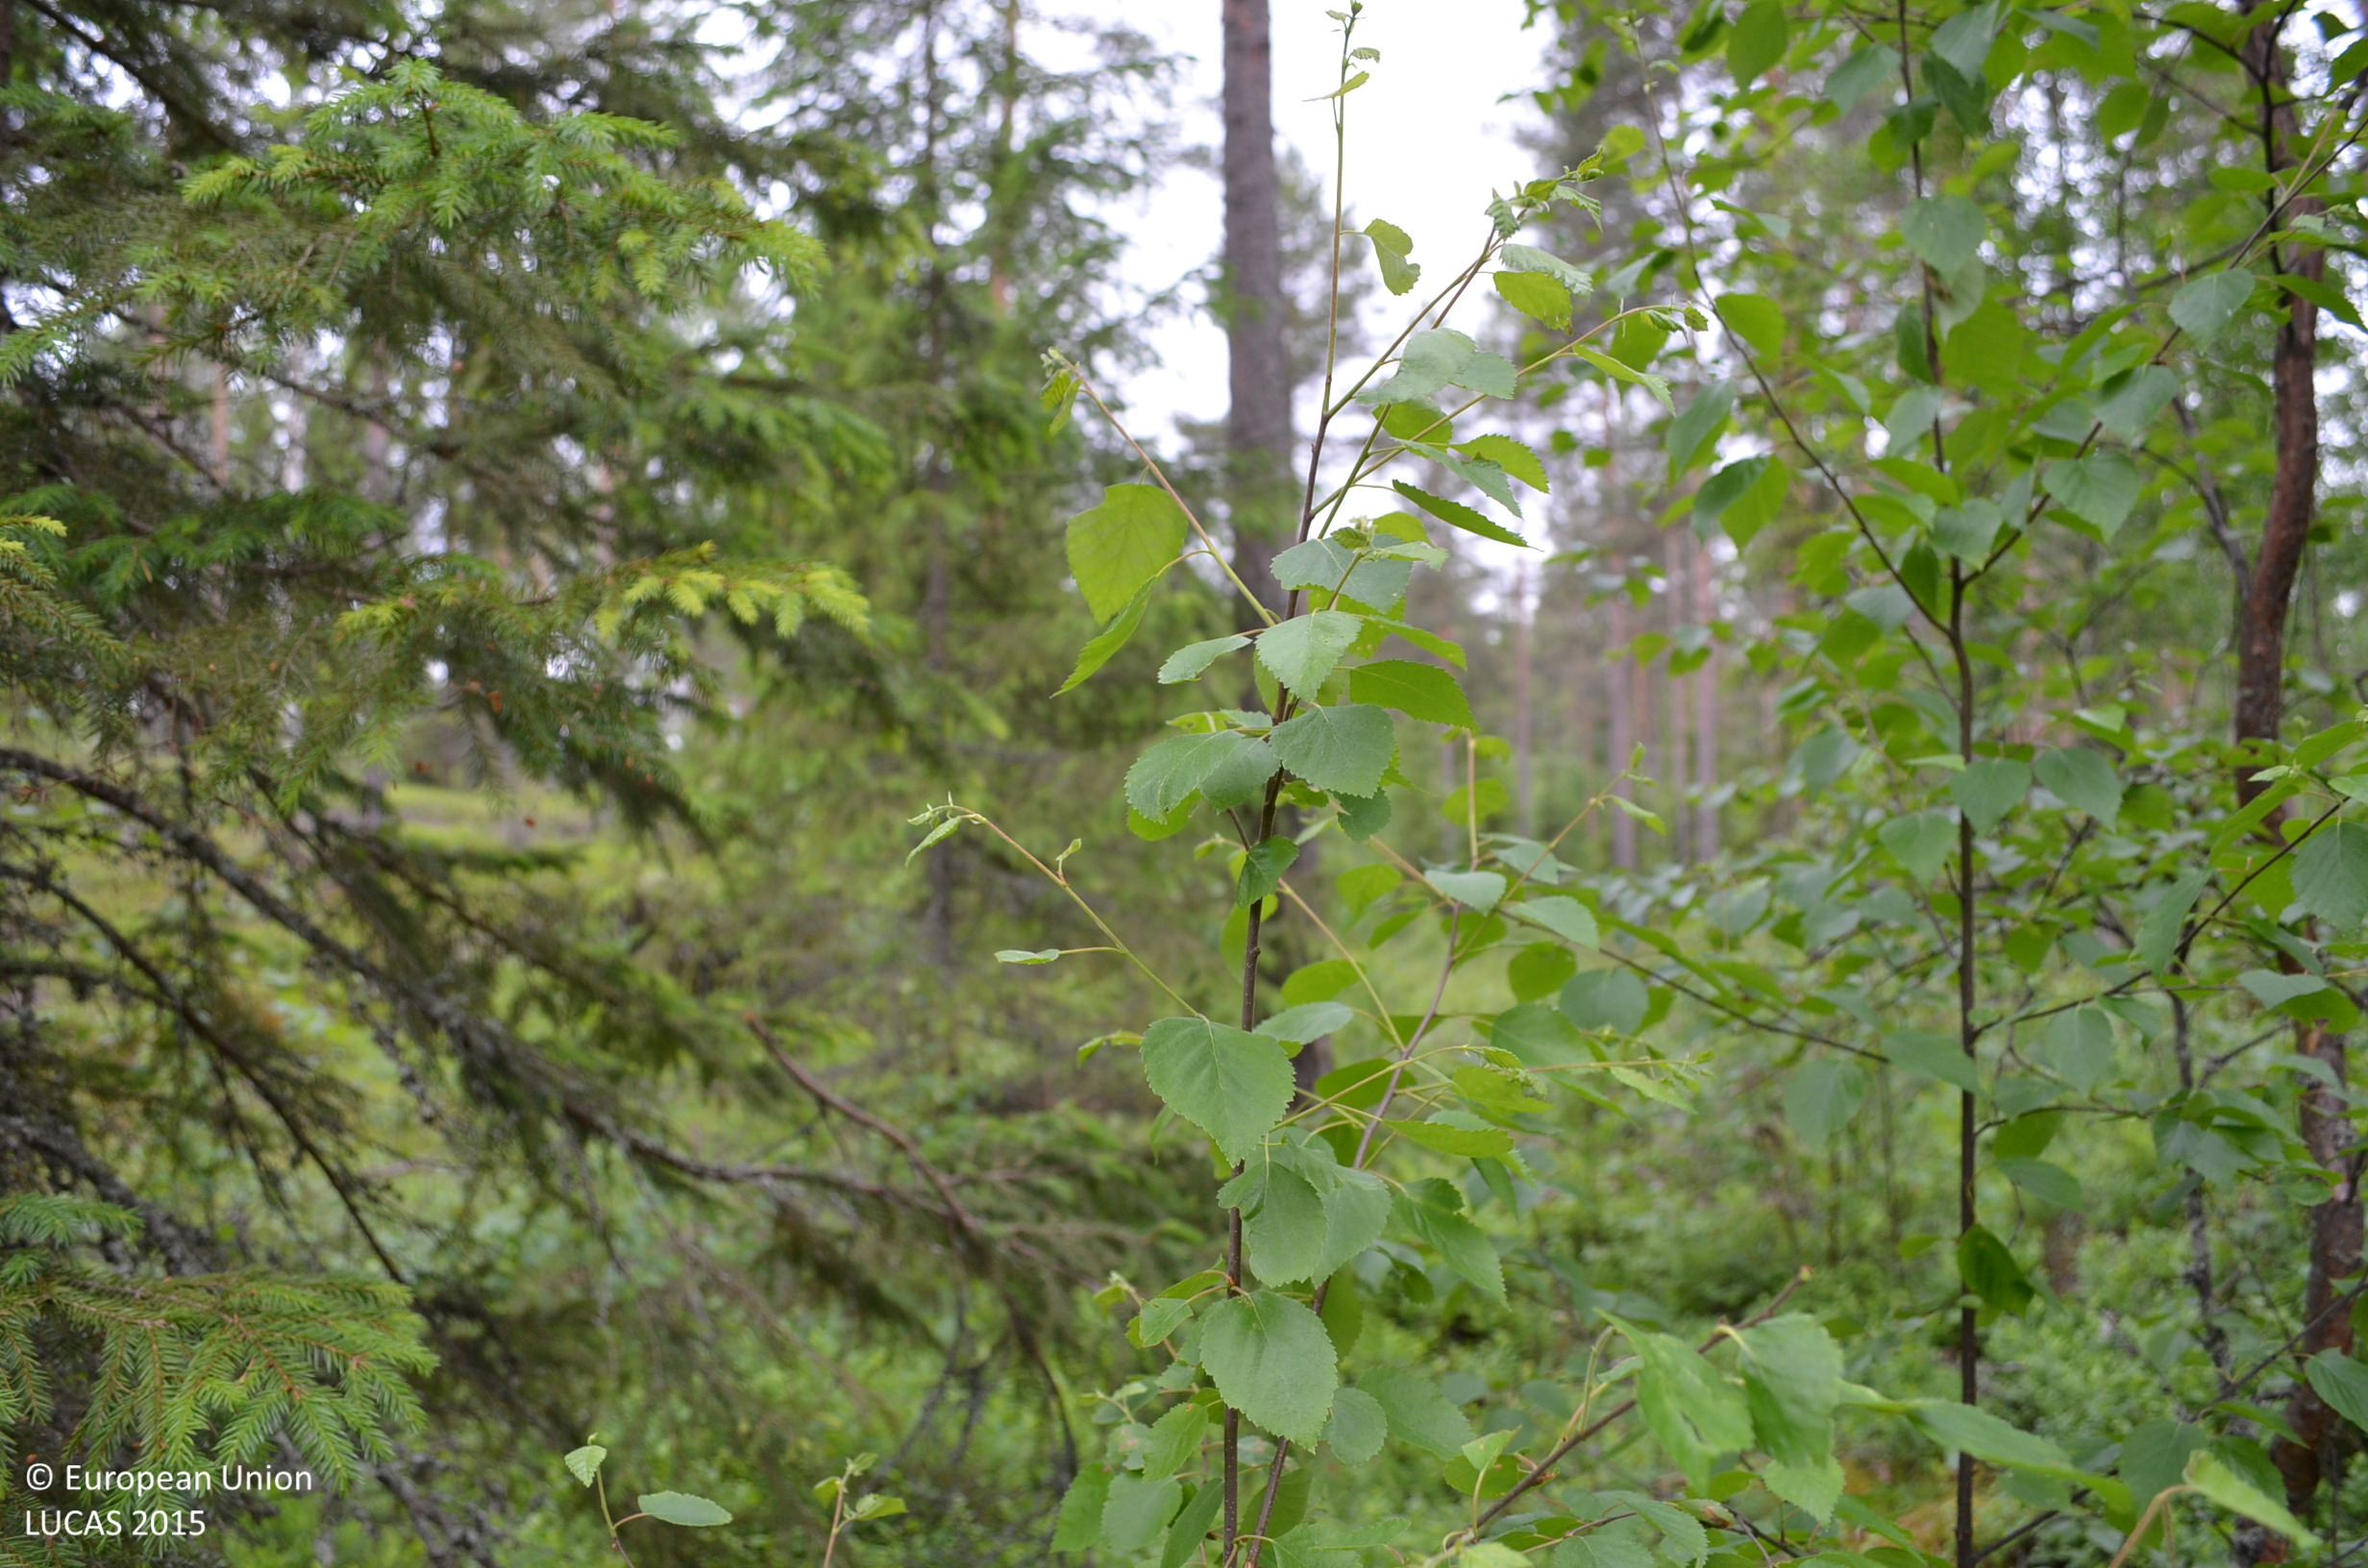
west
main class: Woodland
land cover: Other mixed woodland
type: boreal forest
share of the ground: 50 - 75 %
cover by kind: coniferous forest trees 50 %, shrubs 25 %, broadleaved forest trees 20 %
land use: Forestry
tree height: > 5 m
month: June
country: FI
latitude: 61.6516
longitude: 23.3088
